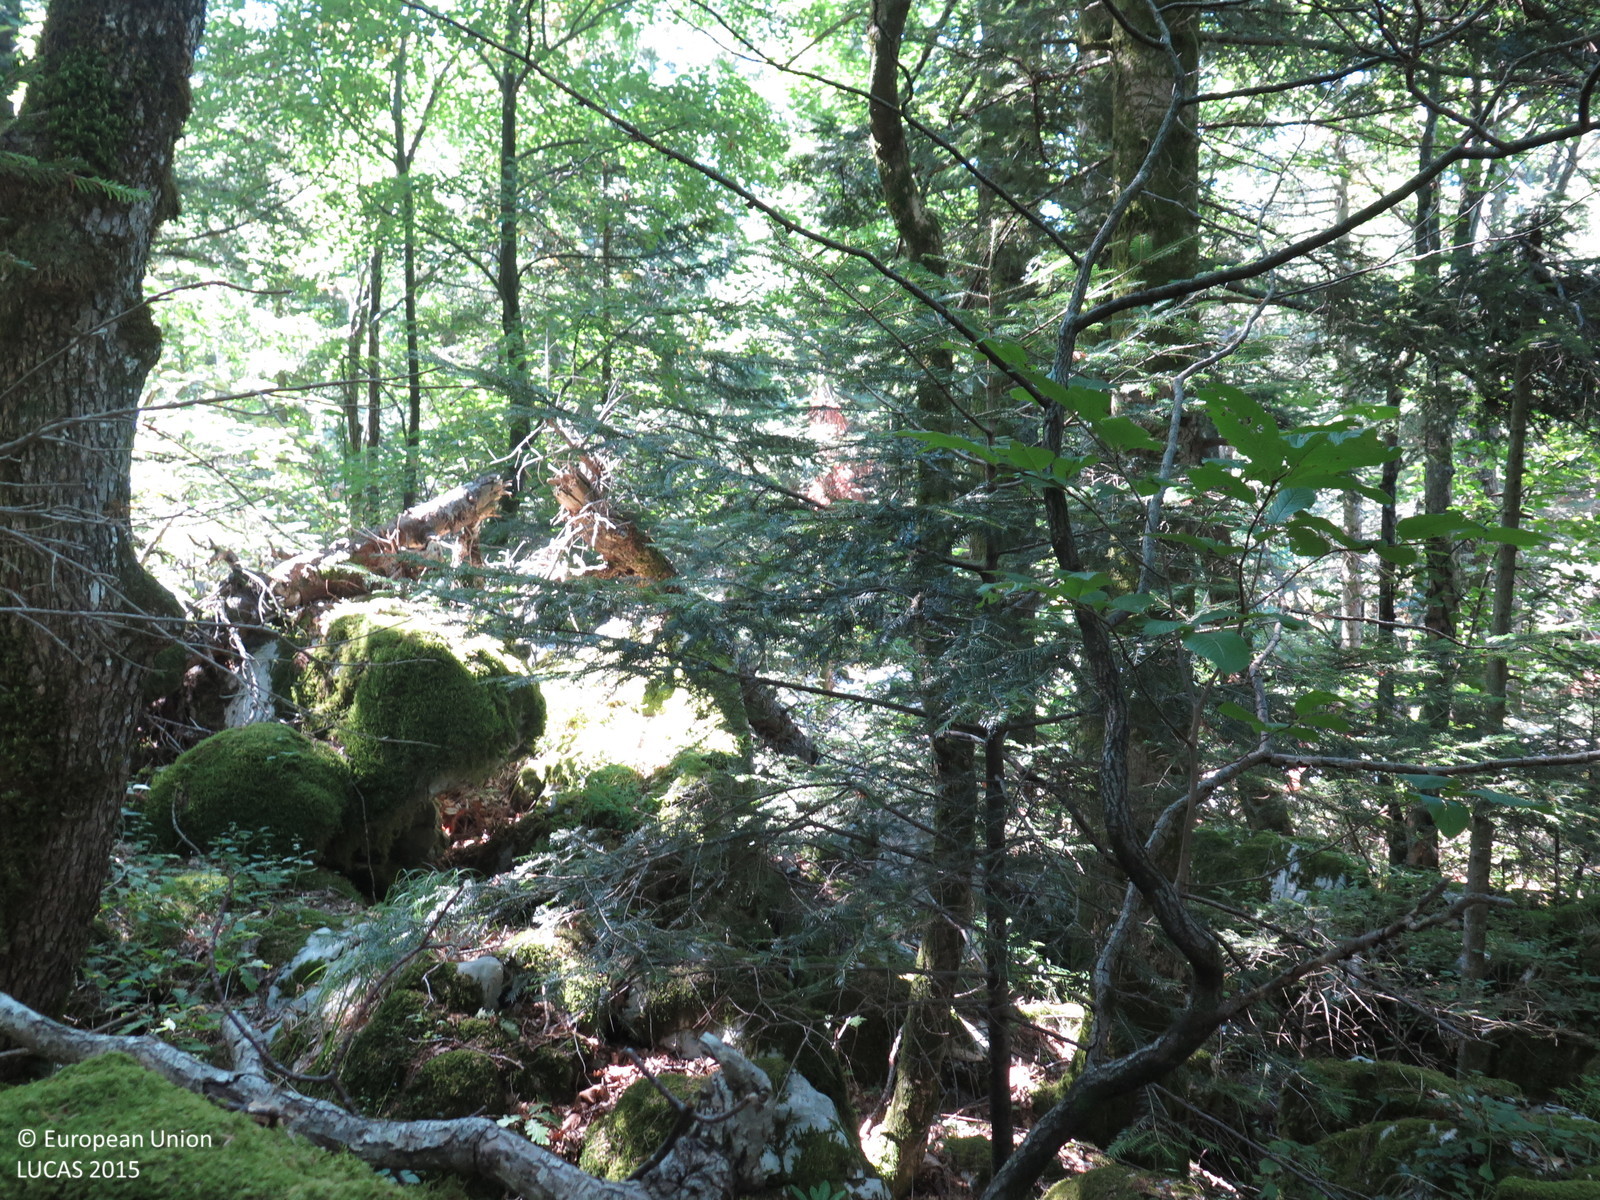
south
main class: Woodland
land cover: Other mixed woodland
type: mountainous beech forest
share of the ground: > 75 %
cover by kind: coniferous forest trees 75 %, broadleaved forest trees 25 %
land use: Forestry
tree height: > 5 m
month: August
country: HR
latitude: 45.1981
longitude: 14.7684
